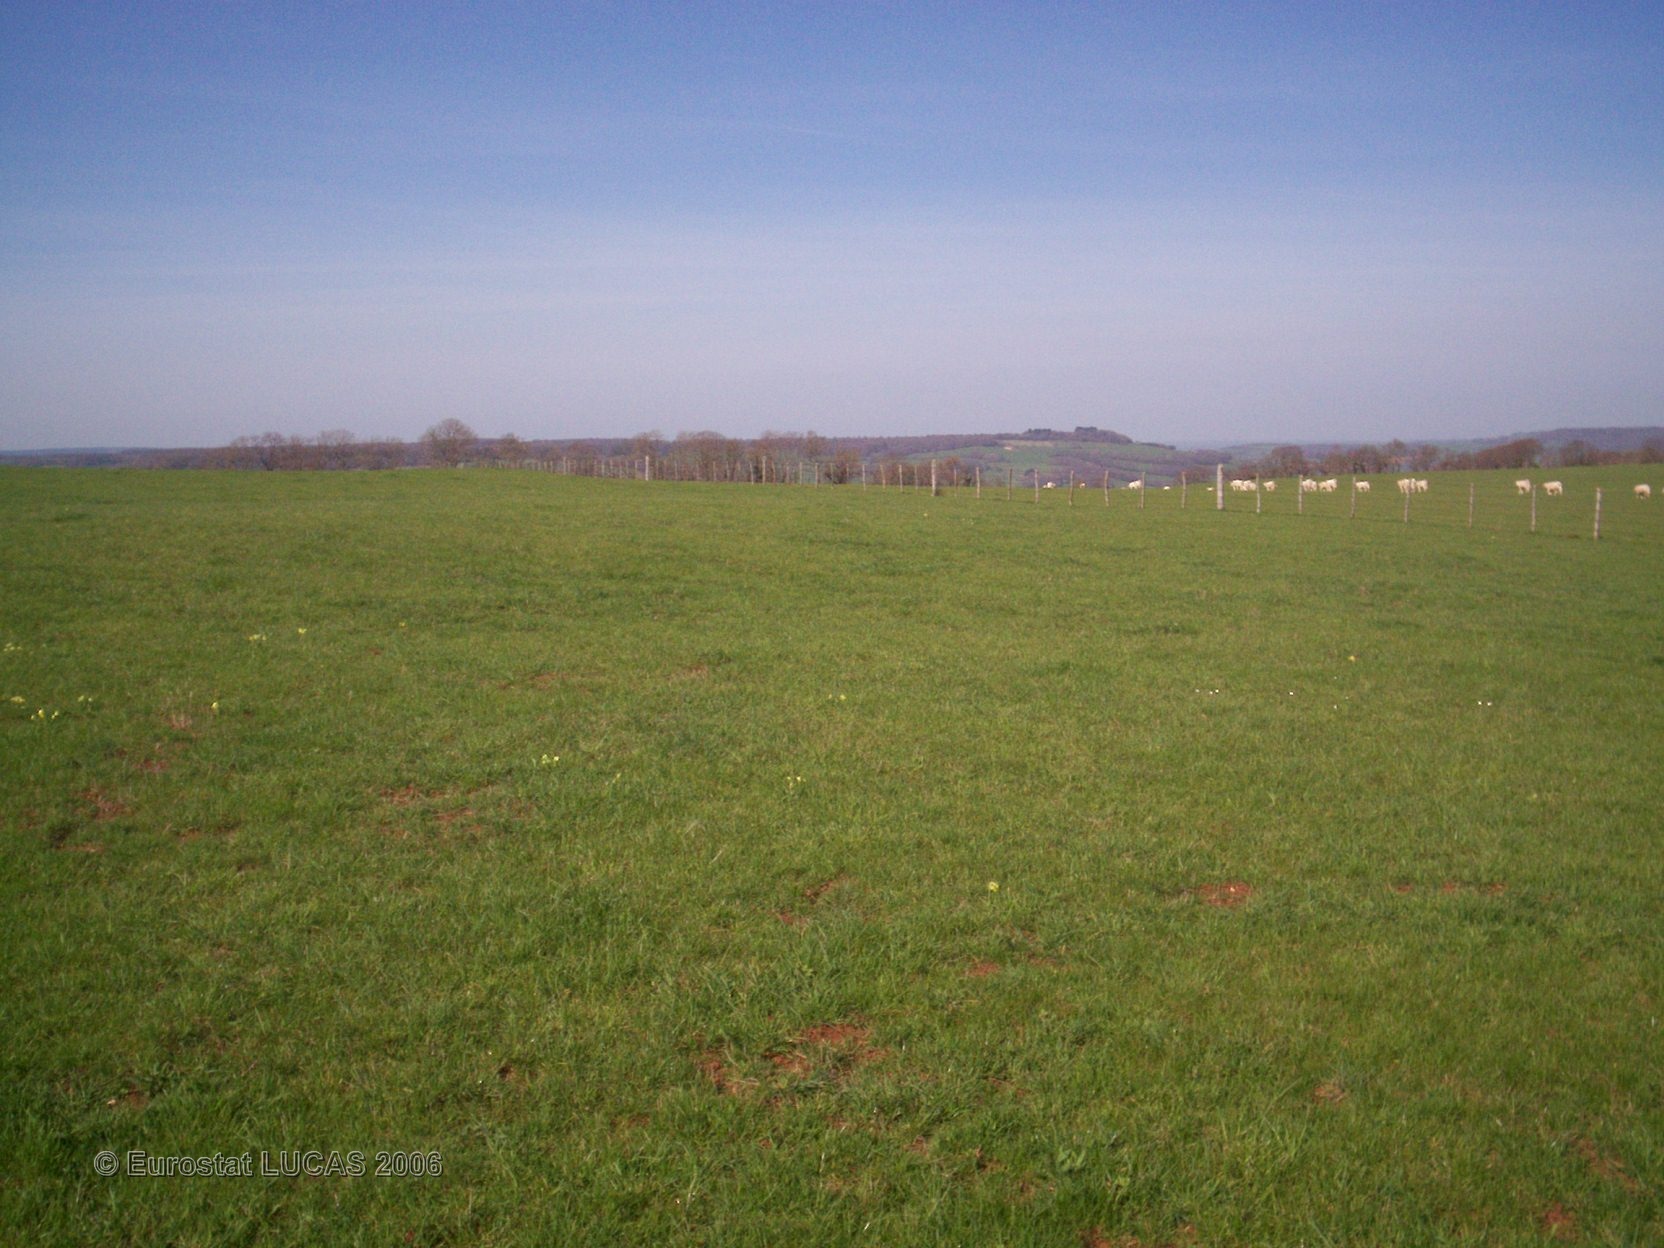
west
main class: Grassland
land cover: Grassland without tree/shrub cover
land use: Agriculture (excluding fallow land and kitchen gardens)
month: April
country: FR
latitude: 47.3869
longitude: 4.5815
